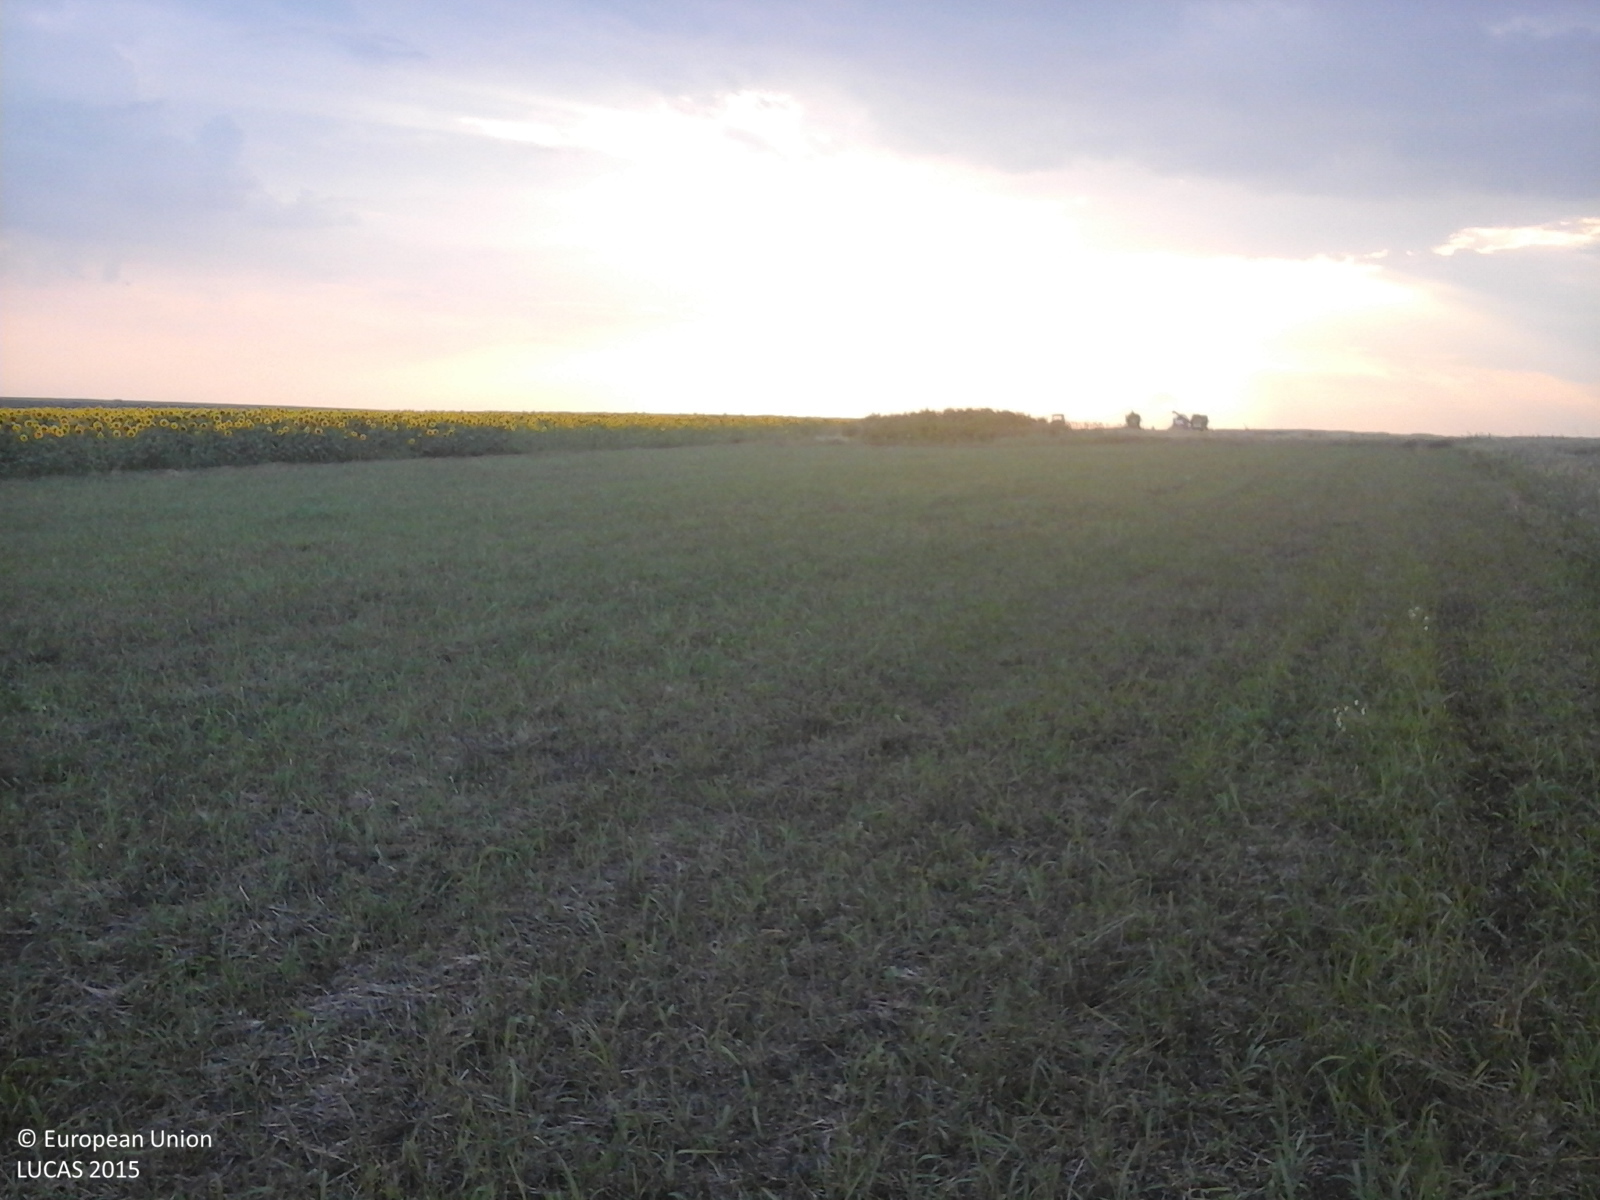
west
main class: Cropland
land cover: Common wheat
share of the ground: > 75 %
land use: Agriculture (excluding fallow land and kitchen gardens)
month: July
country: RO
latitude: 43.9825
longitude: 24.7704
